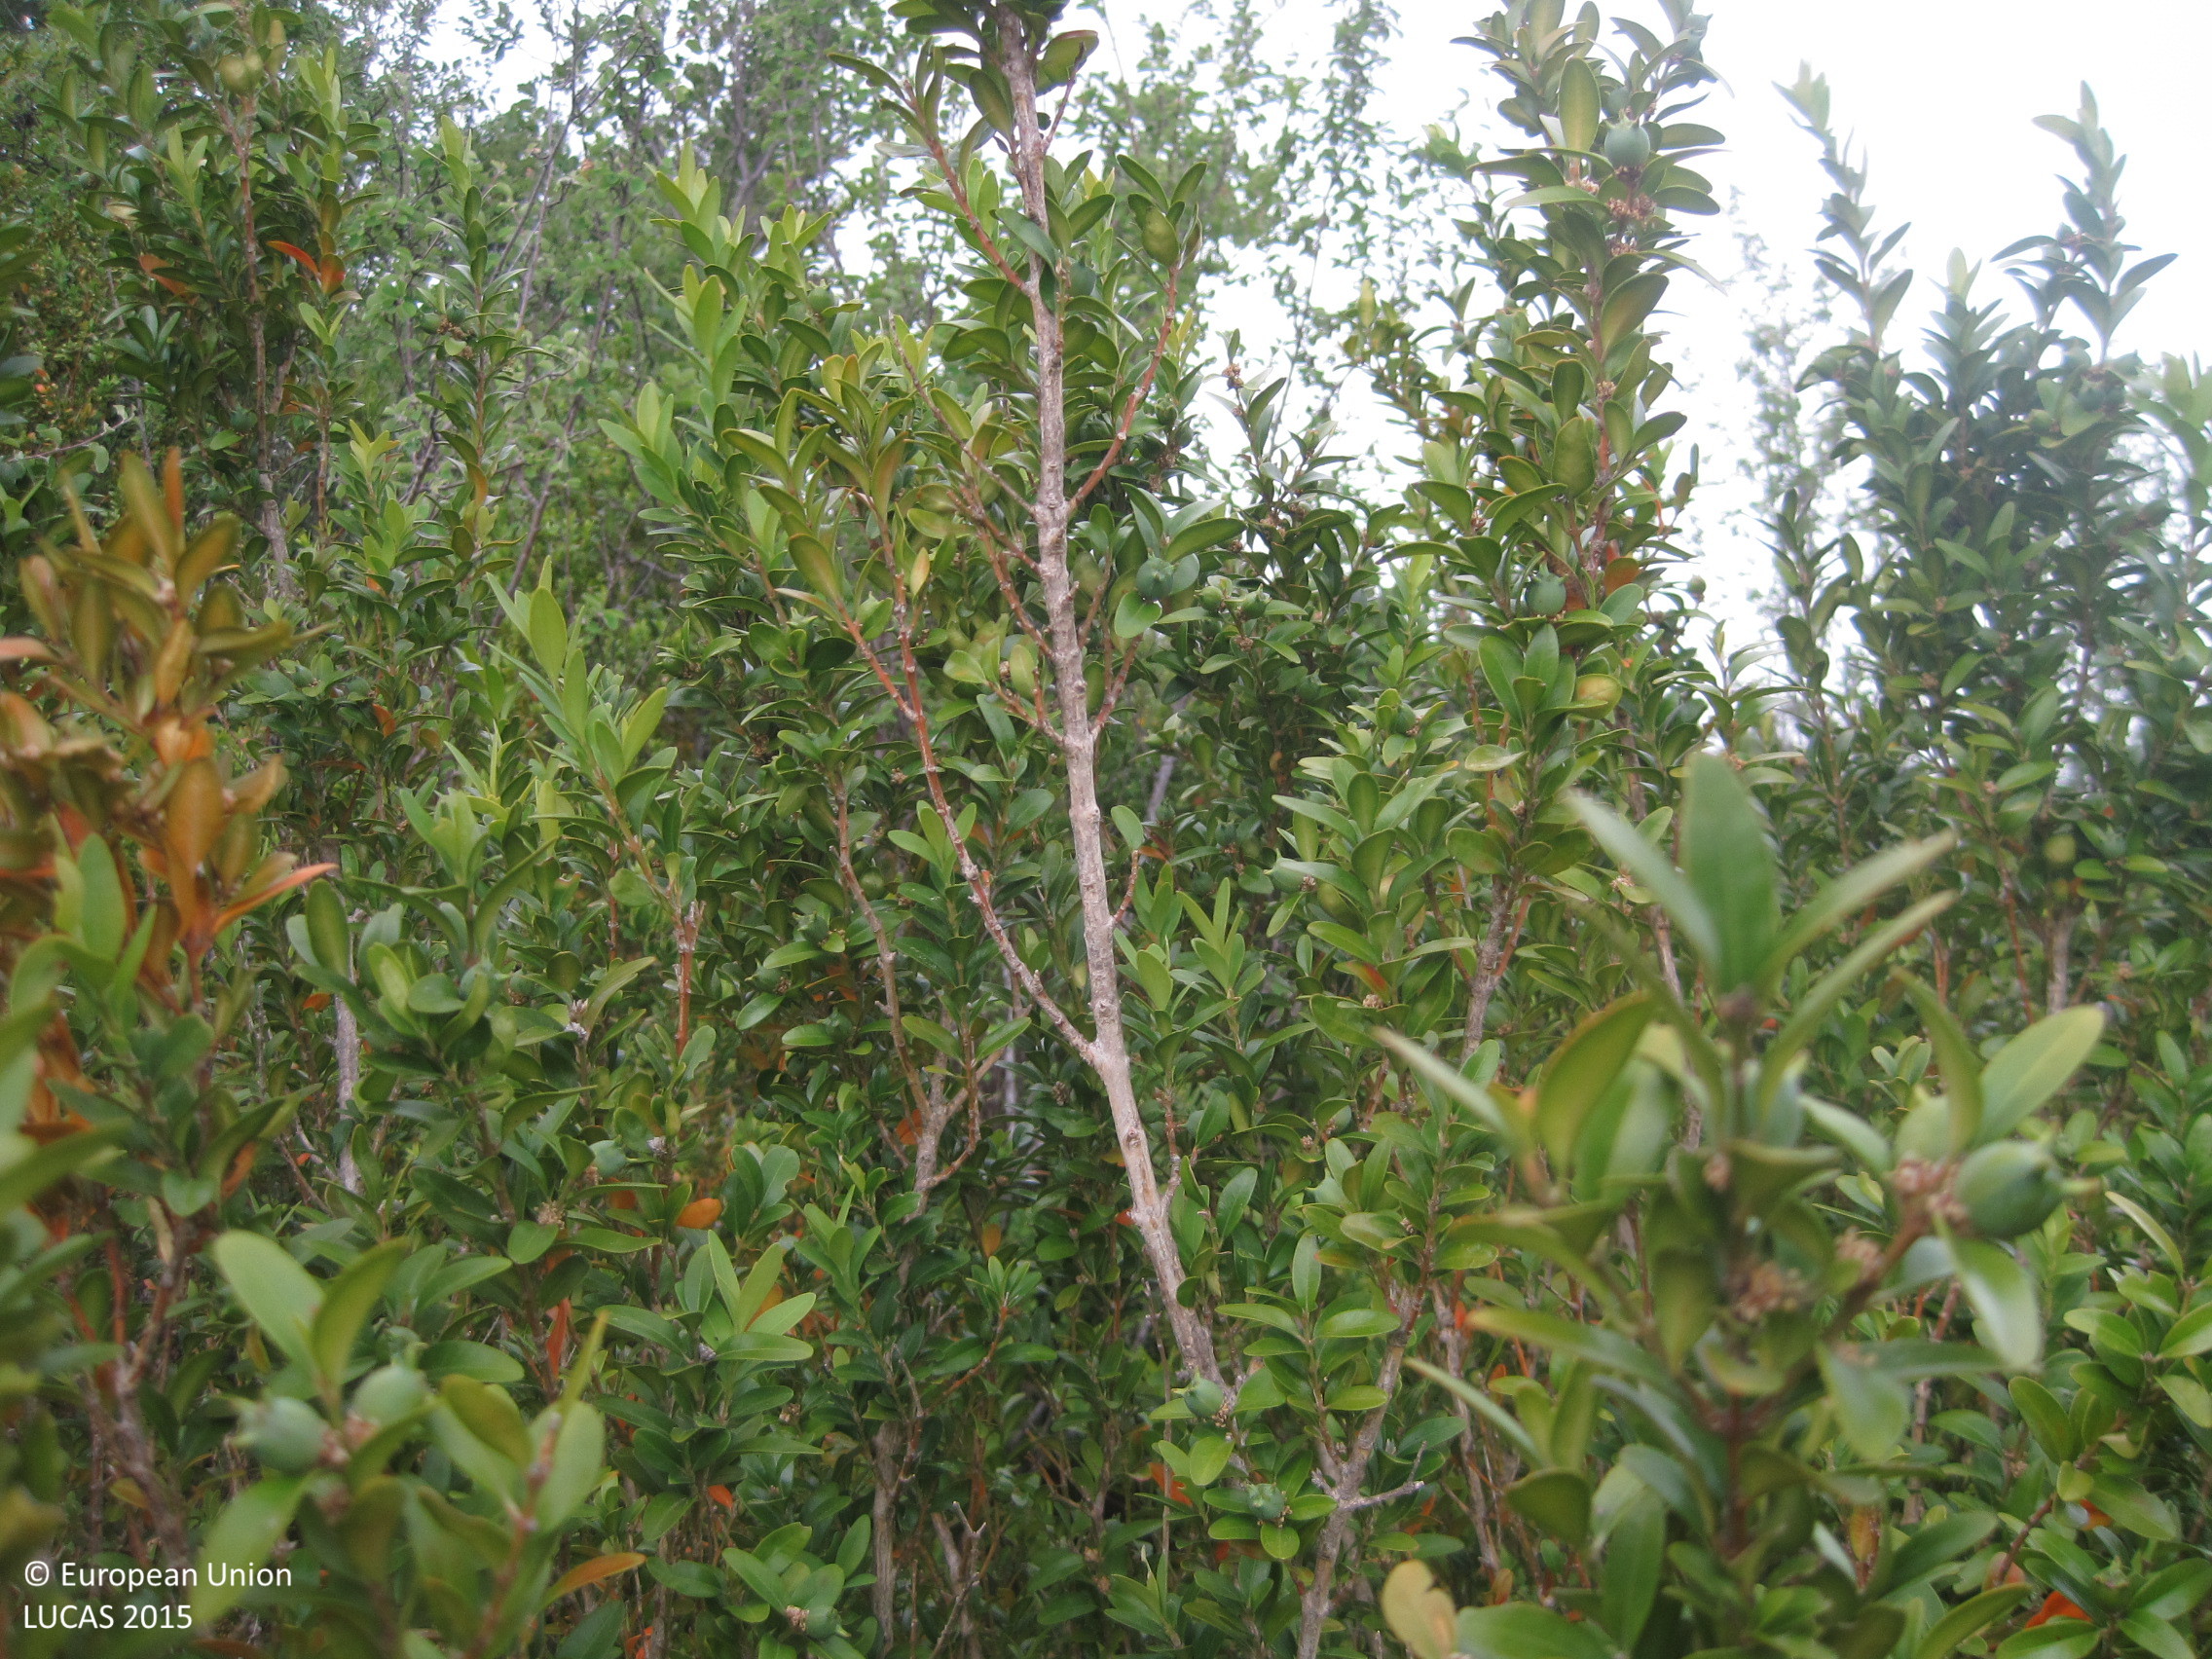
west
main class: Shrubland
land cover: Shrubland without tree cover
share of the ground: > 75 %
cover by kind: shrubs 95 %, herbaceous plants 5 %
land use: Semi-natural and natural areas not in use
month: May
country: ES
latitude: 42.5880
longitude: -1.4285
